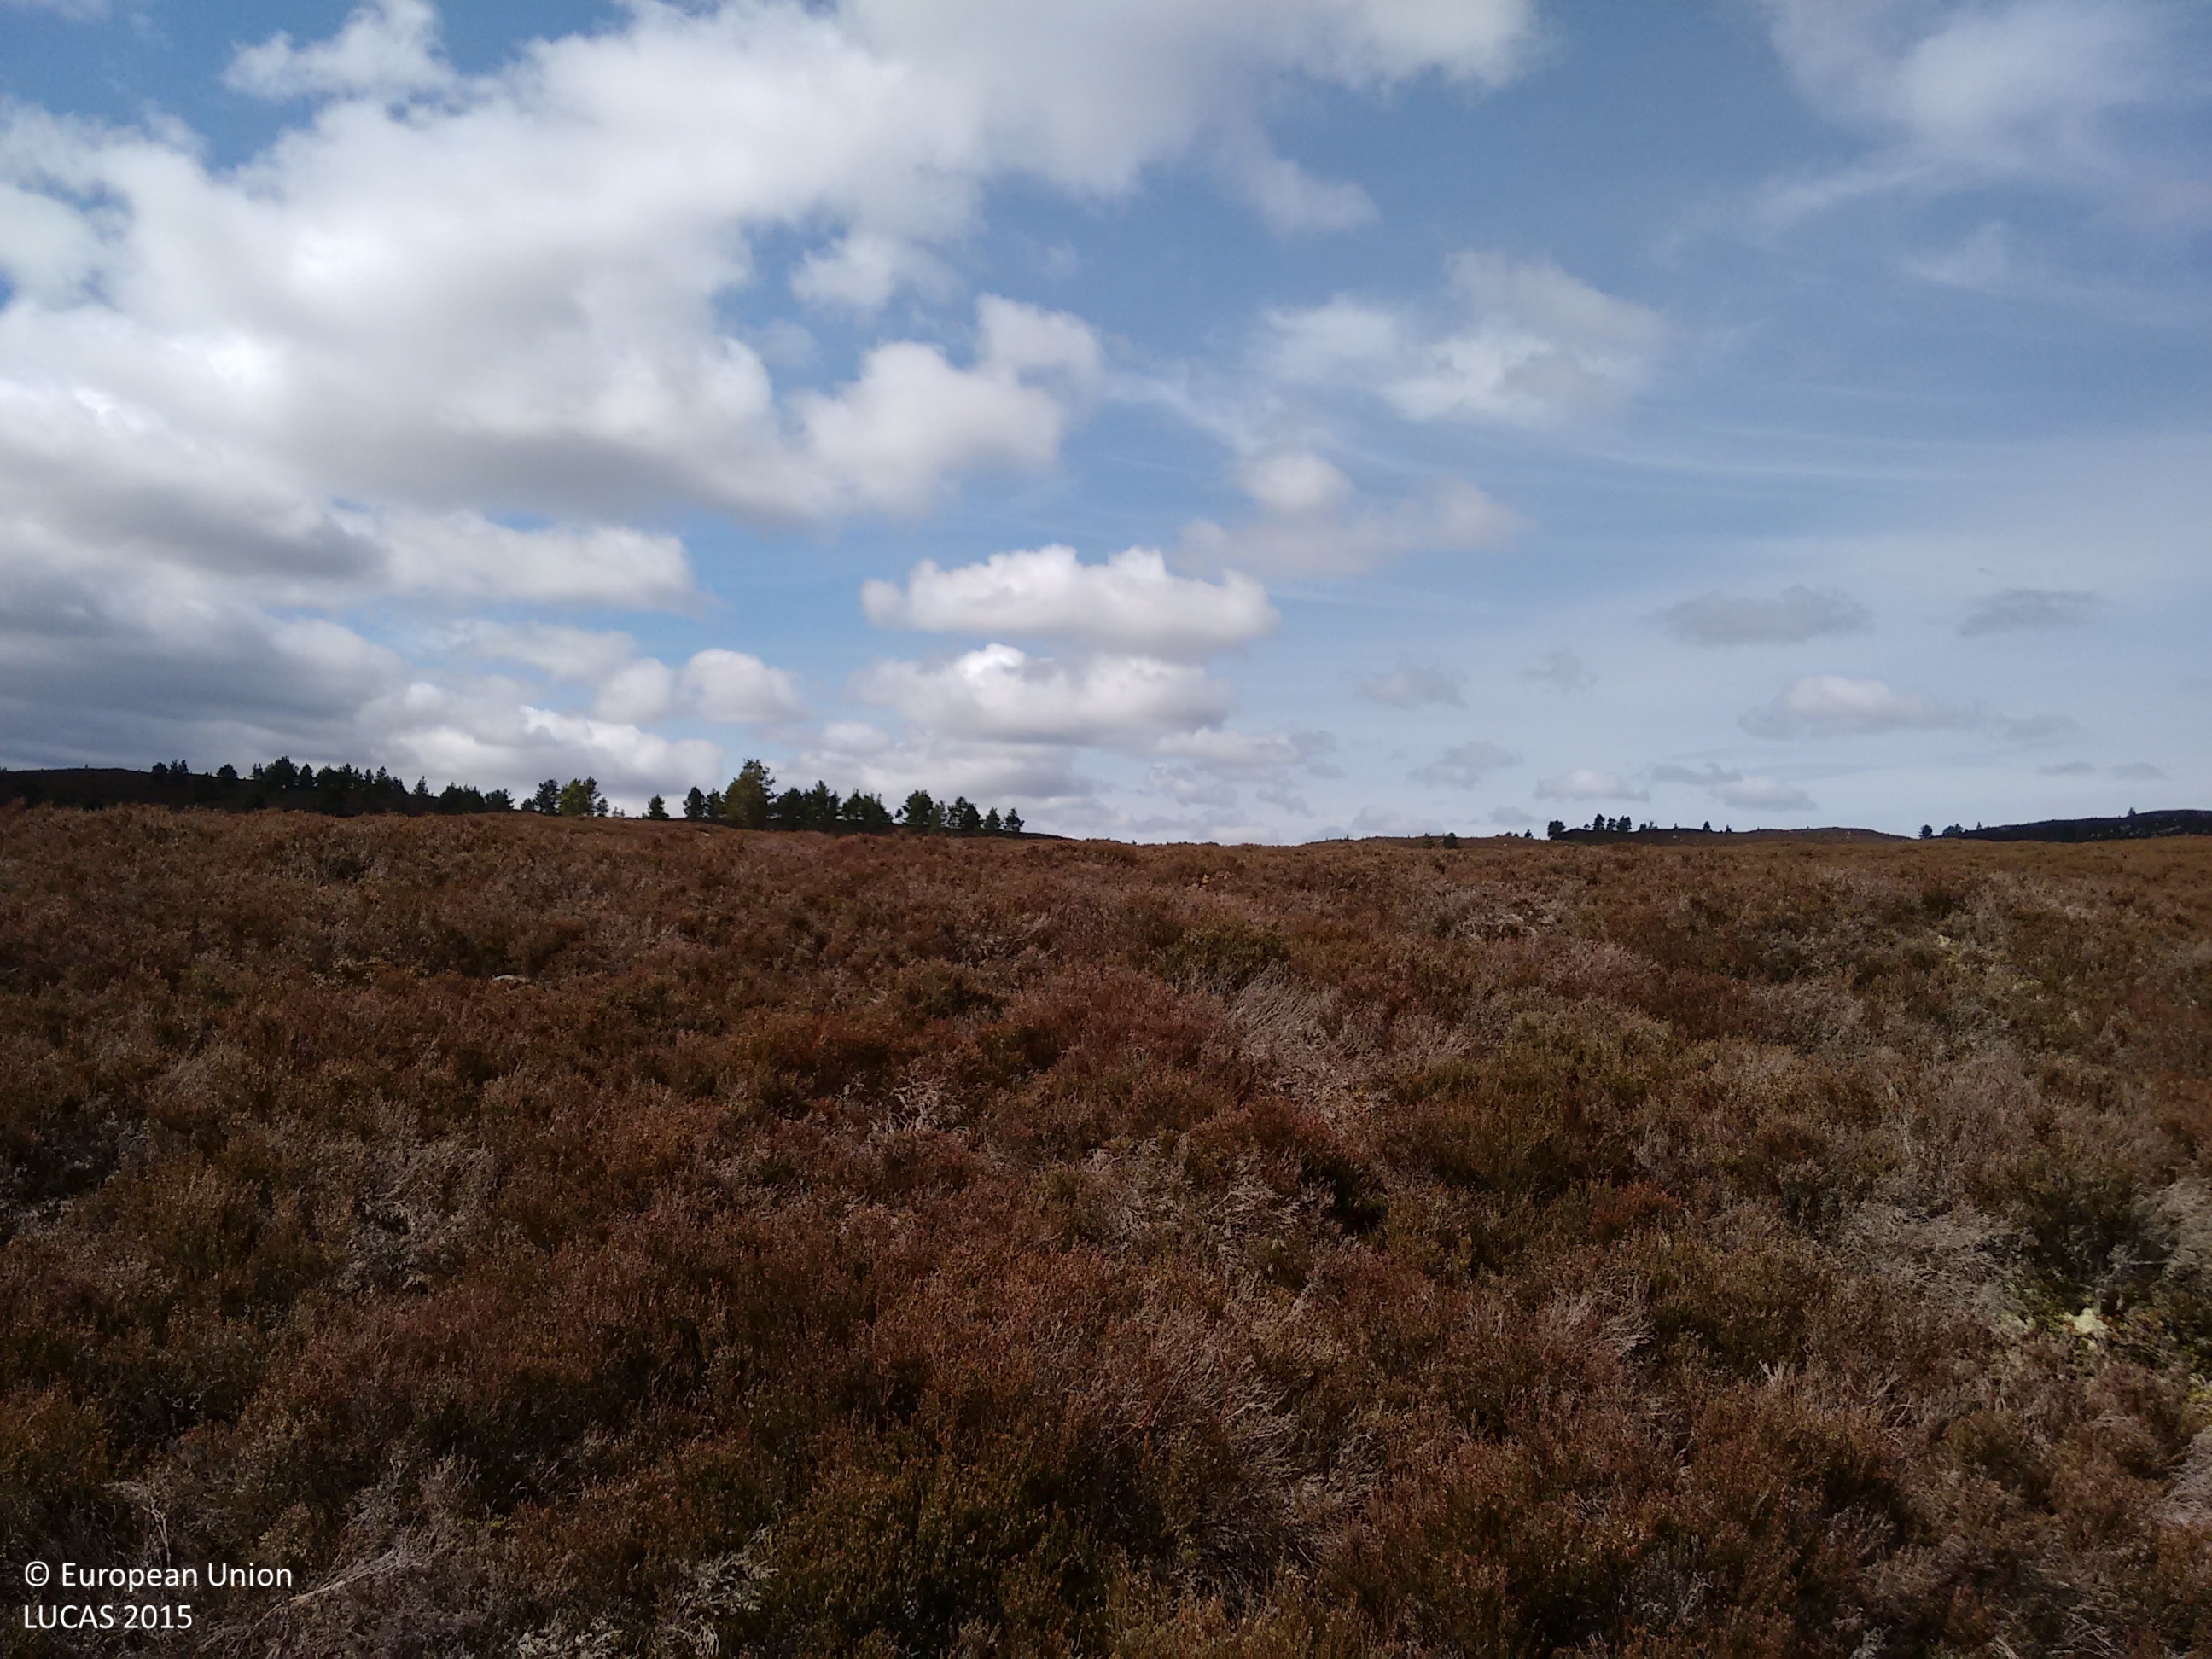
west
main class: Shrubland
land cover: Shrubland without tree cover
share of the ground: > 75 %
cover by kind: shrubs 85 %, herbaceous plants 10 %, lichens and mosses 5 %
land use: Agriculture (excluding fallow land and kitchen gardens)
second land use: Other primary production
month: June
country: GB
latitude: 57.3258
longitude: -3.7445
